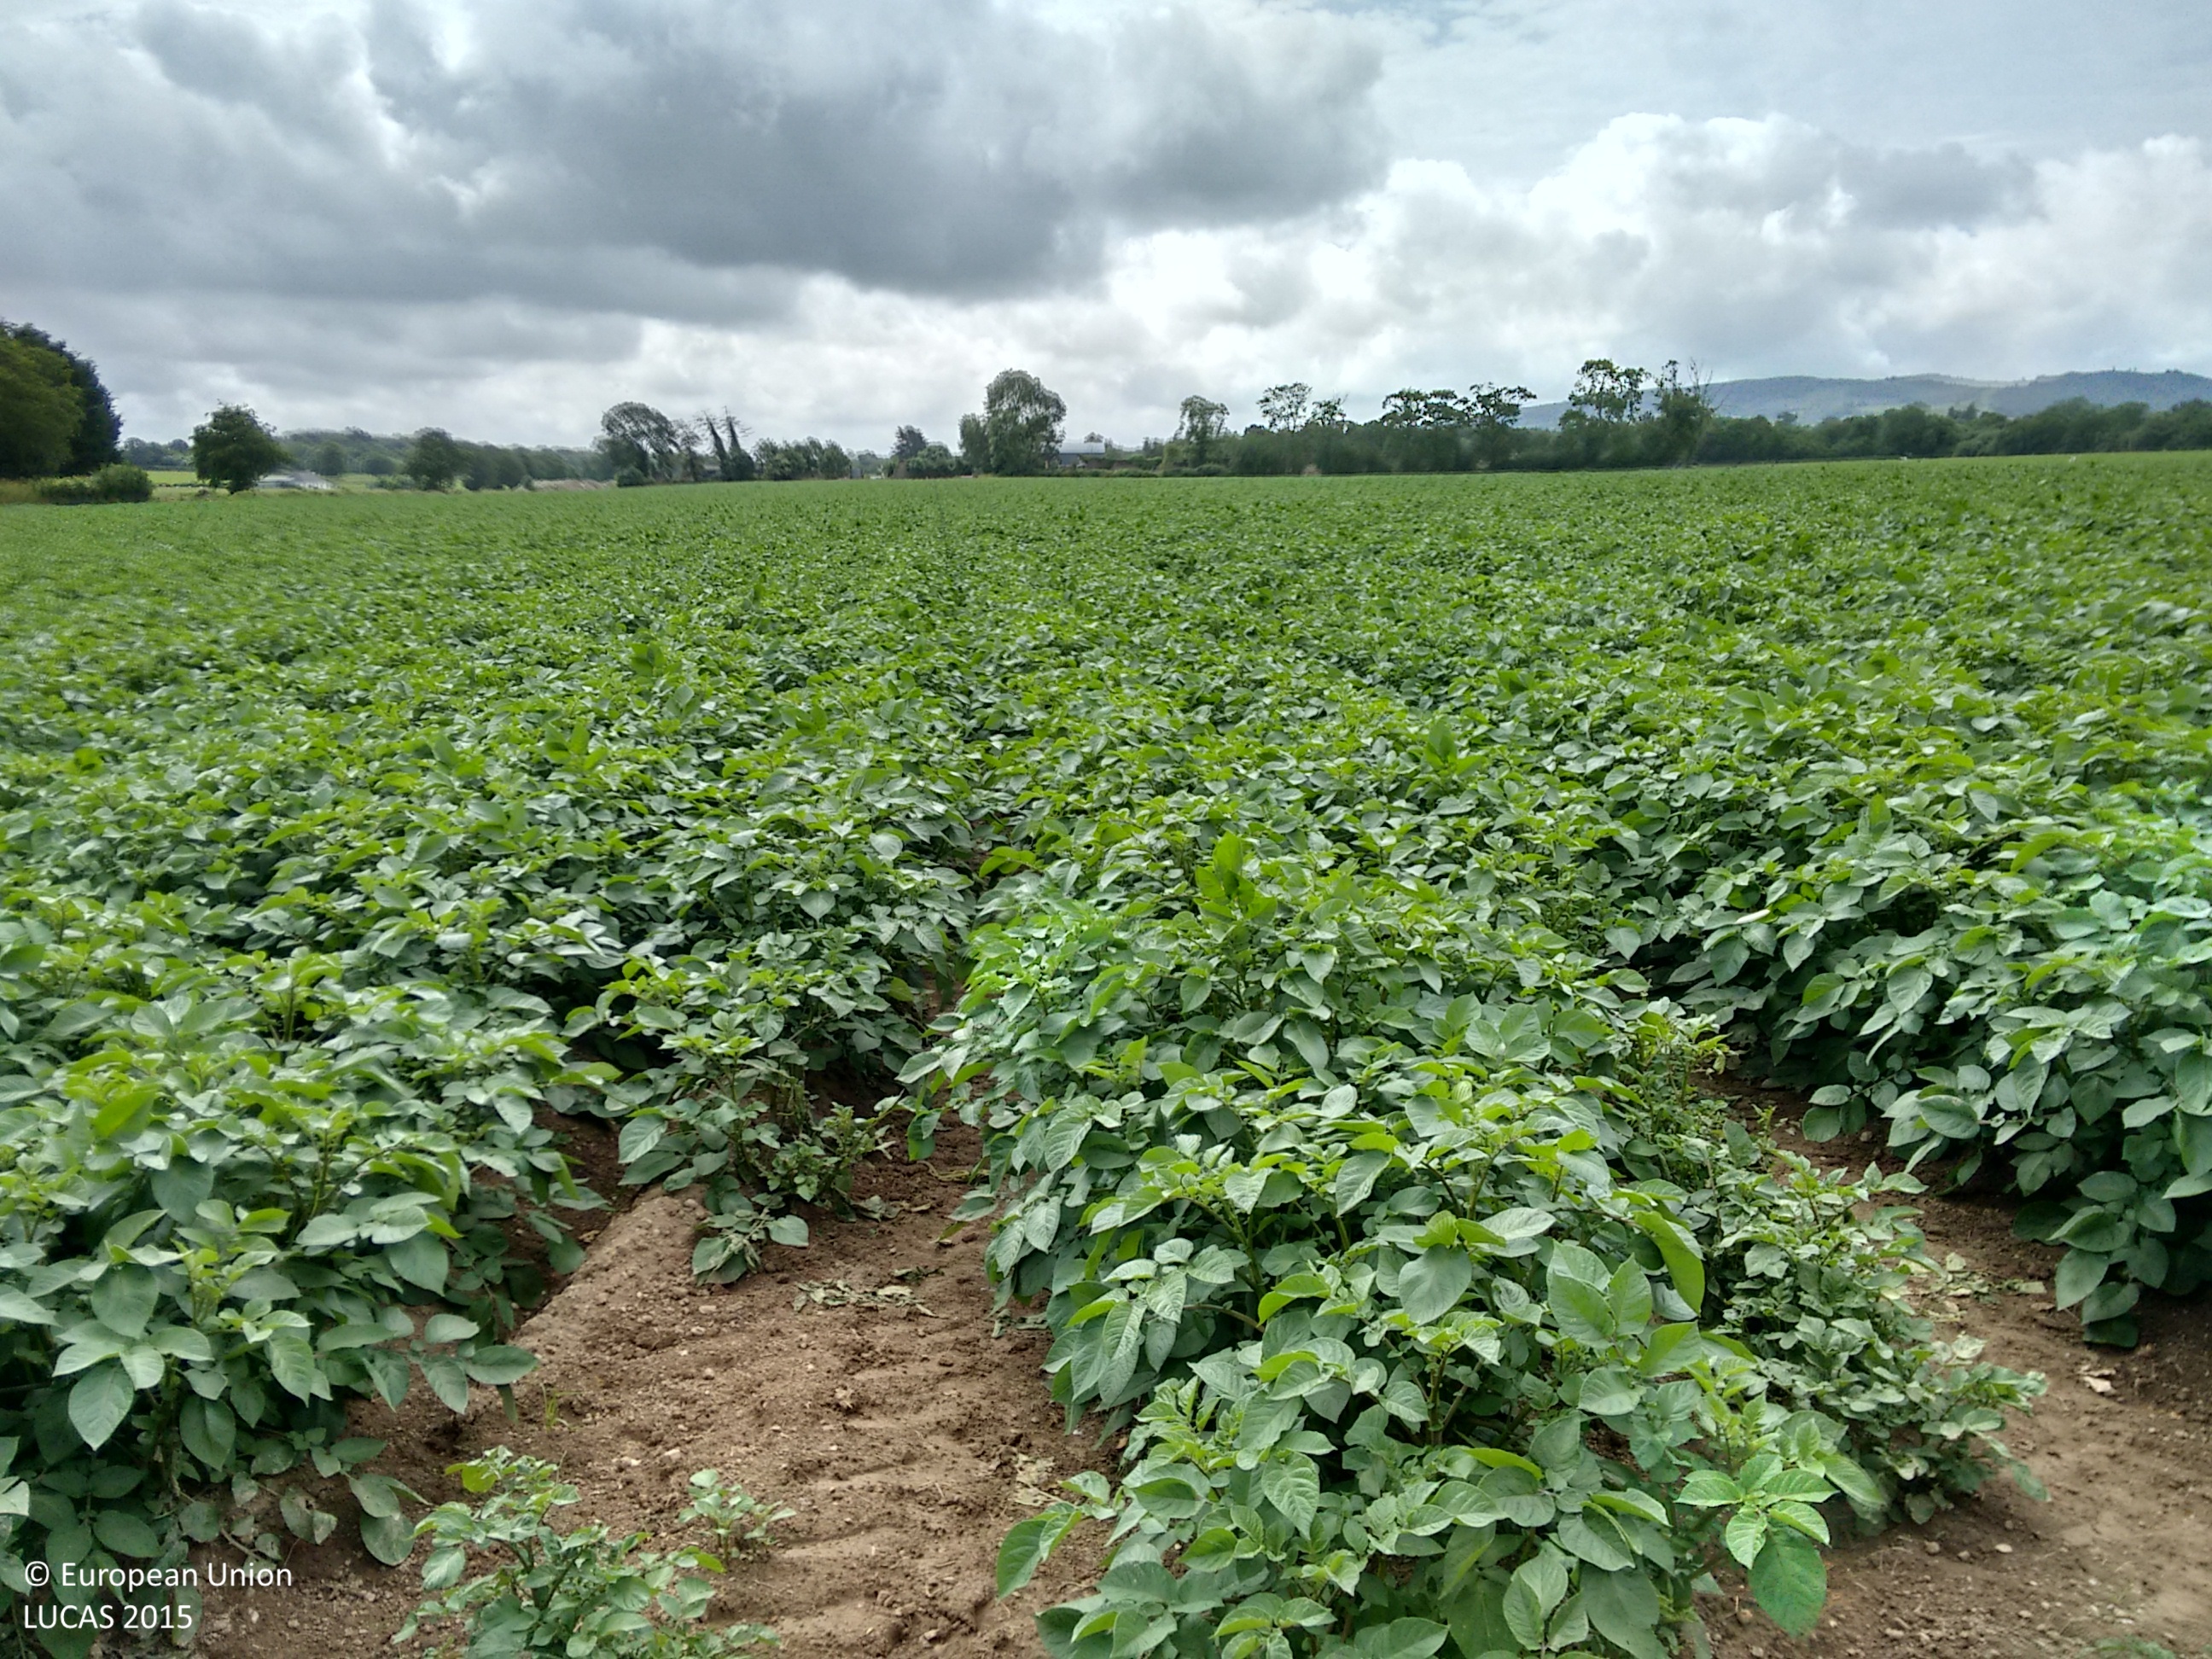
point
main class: Cropland
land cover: Potatoes
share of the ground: > 75 %
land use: Agriculture (excluding fallow land and kitchen gardens)
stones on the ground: < 10 %
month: June
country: IE
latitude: 52.3738
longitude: -7.3547
